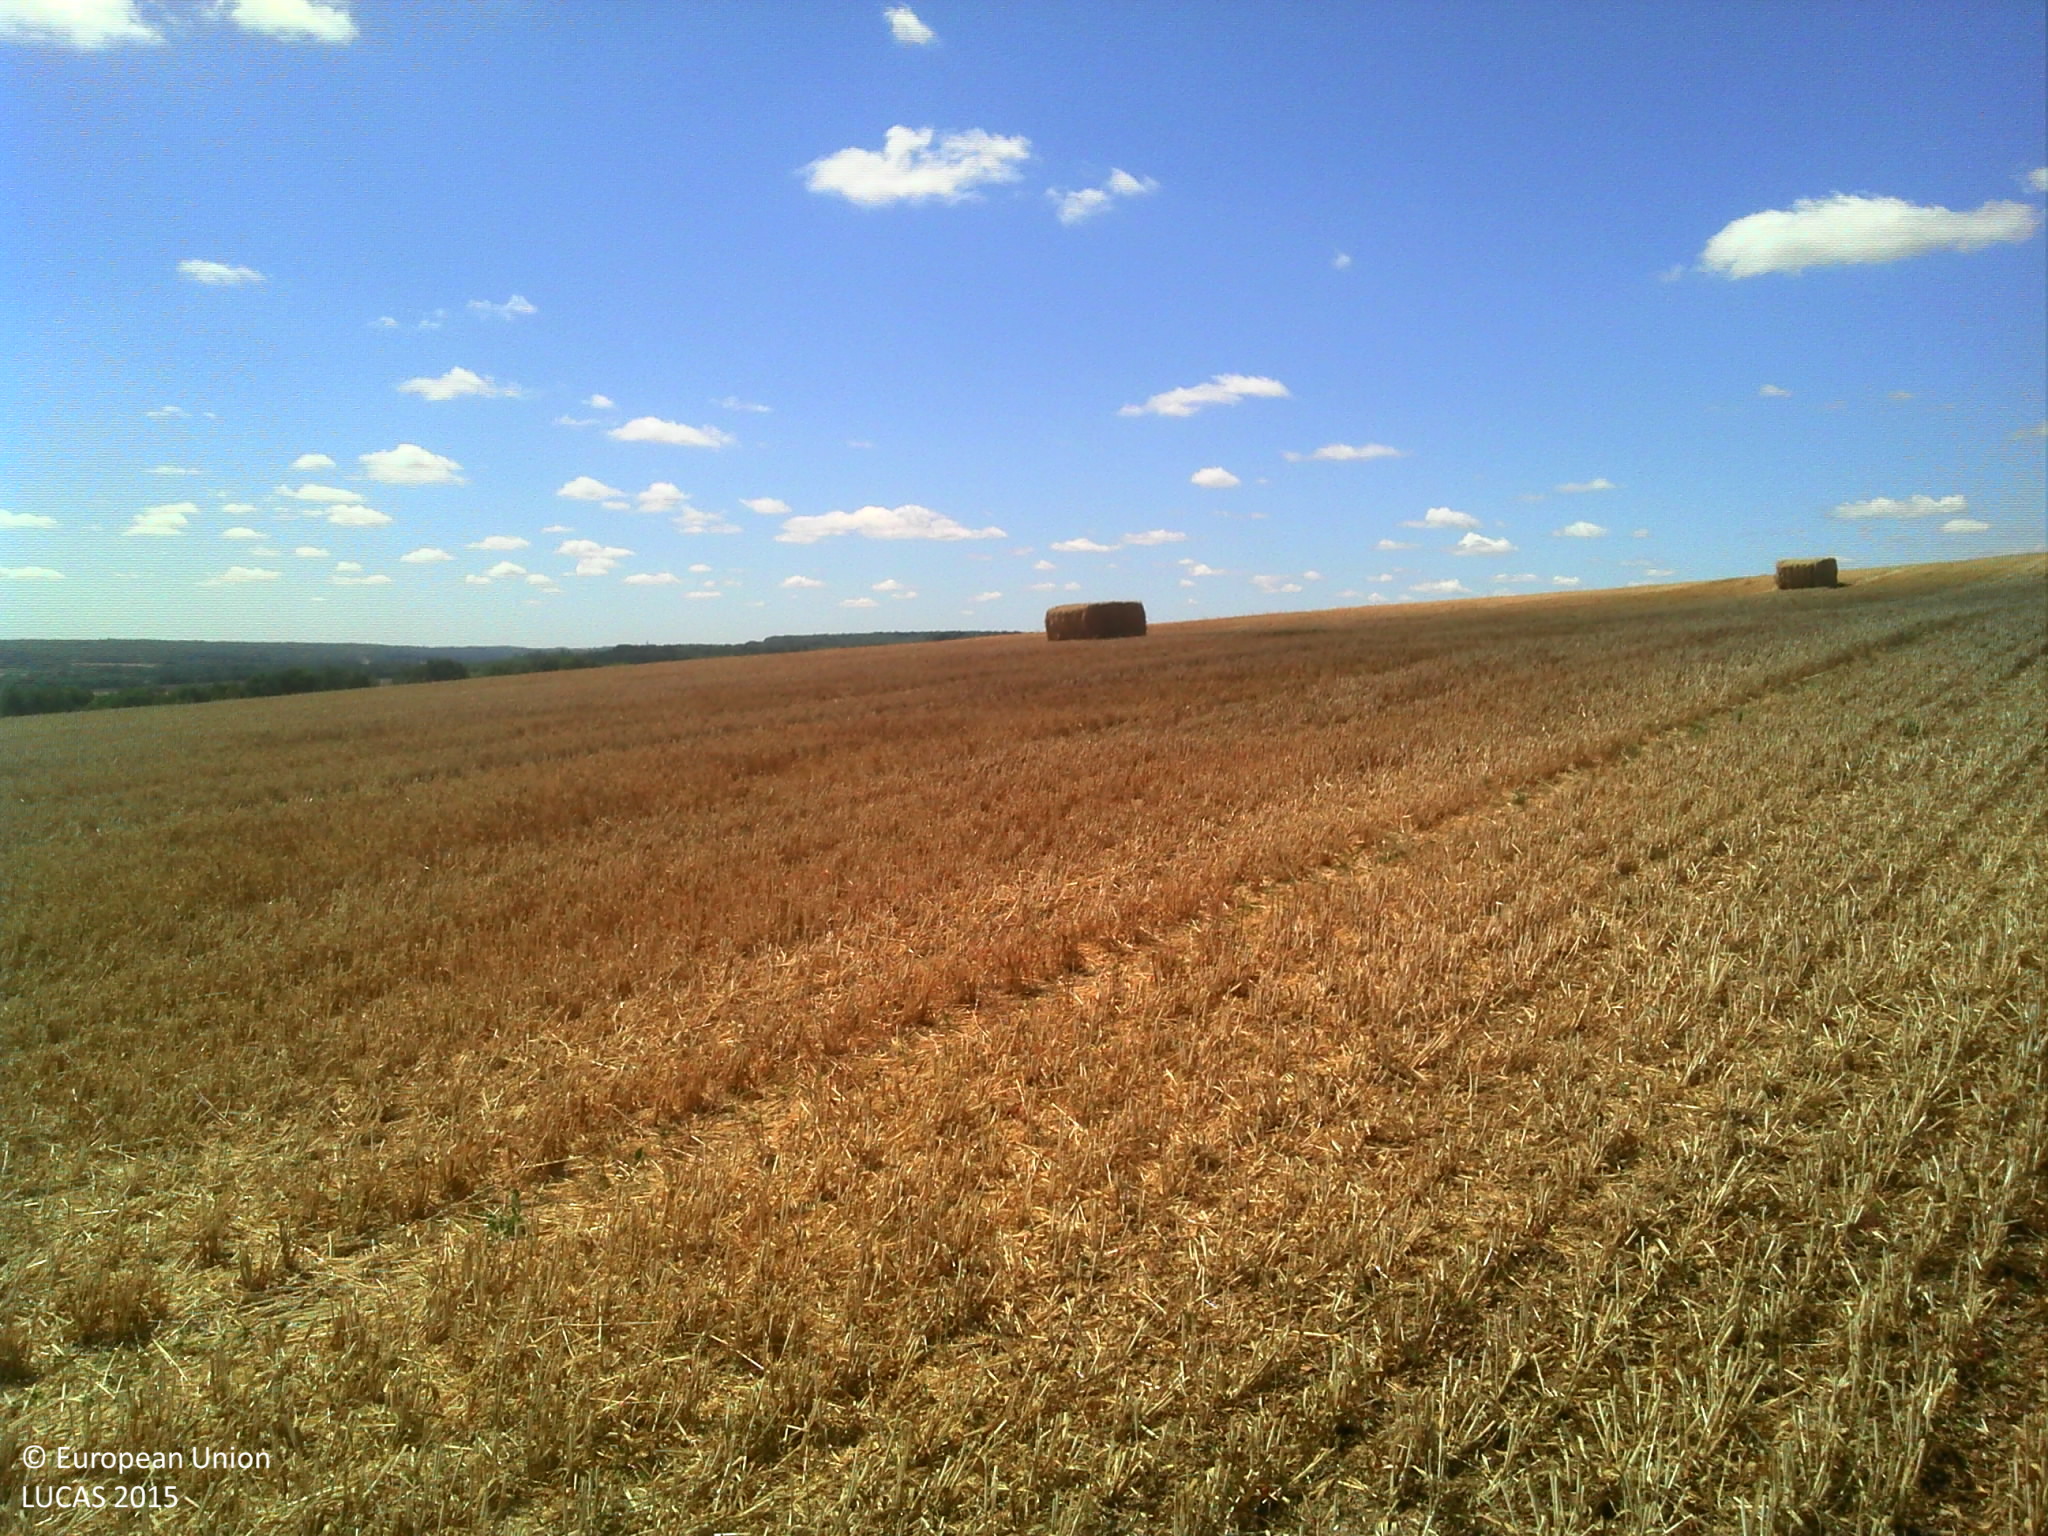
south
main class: Cropland
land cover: Barley
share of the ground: 10 - 25 %
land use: Agriculture (excluding fallow land and kitchen gardens)
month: July
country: FR
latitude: 47.9194
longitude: 5.1688
